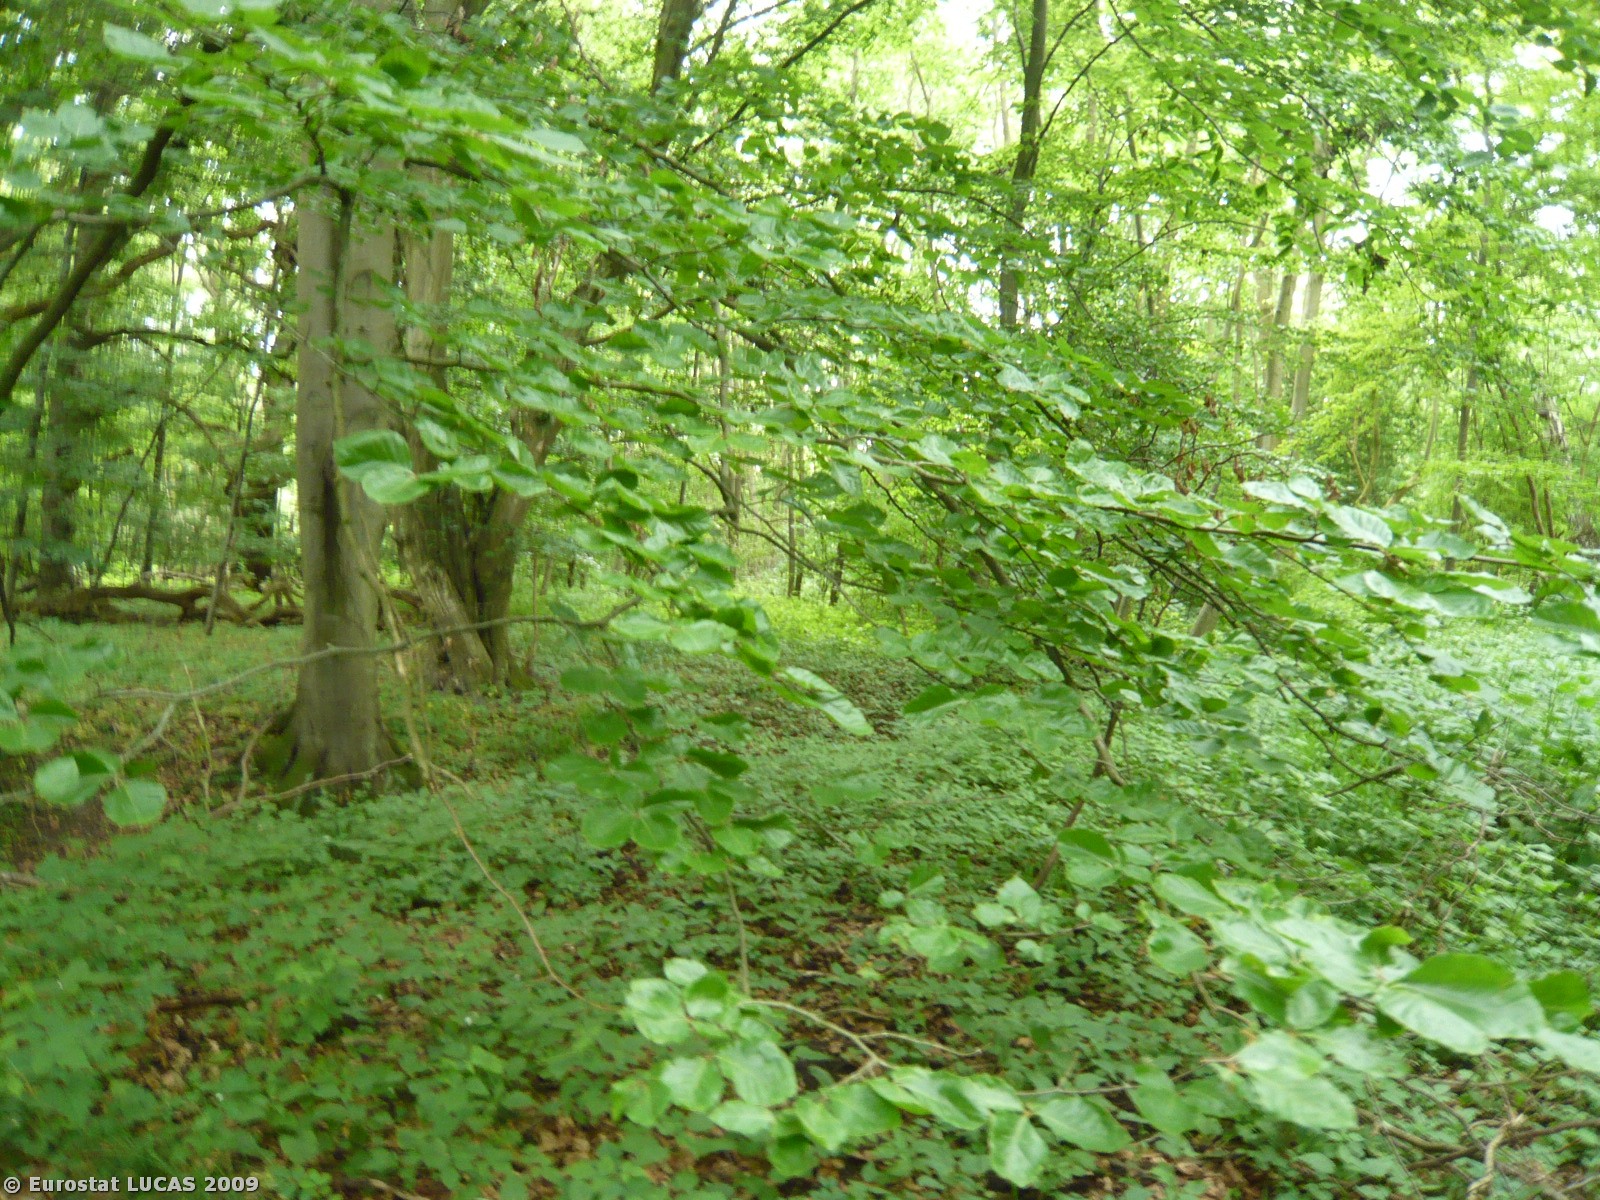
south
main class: Woodland
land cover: Broadleaved woodland
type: mesophytic deciduous forest
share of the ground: > 75 %
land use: Forestry
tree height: > 5 m
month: June
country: DK
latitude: 54.7747
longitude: 11.6623
